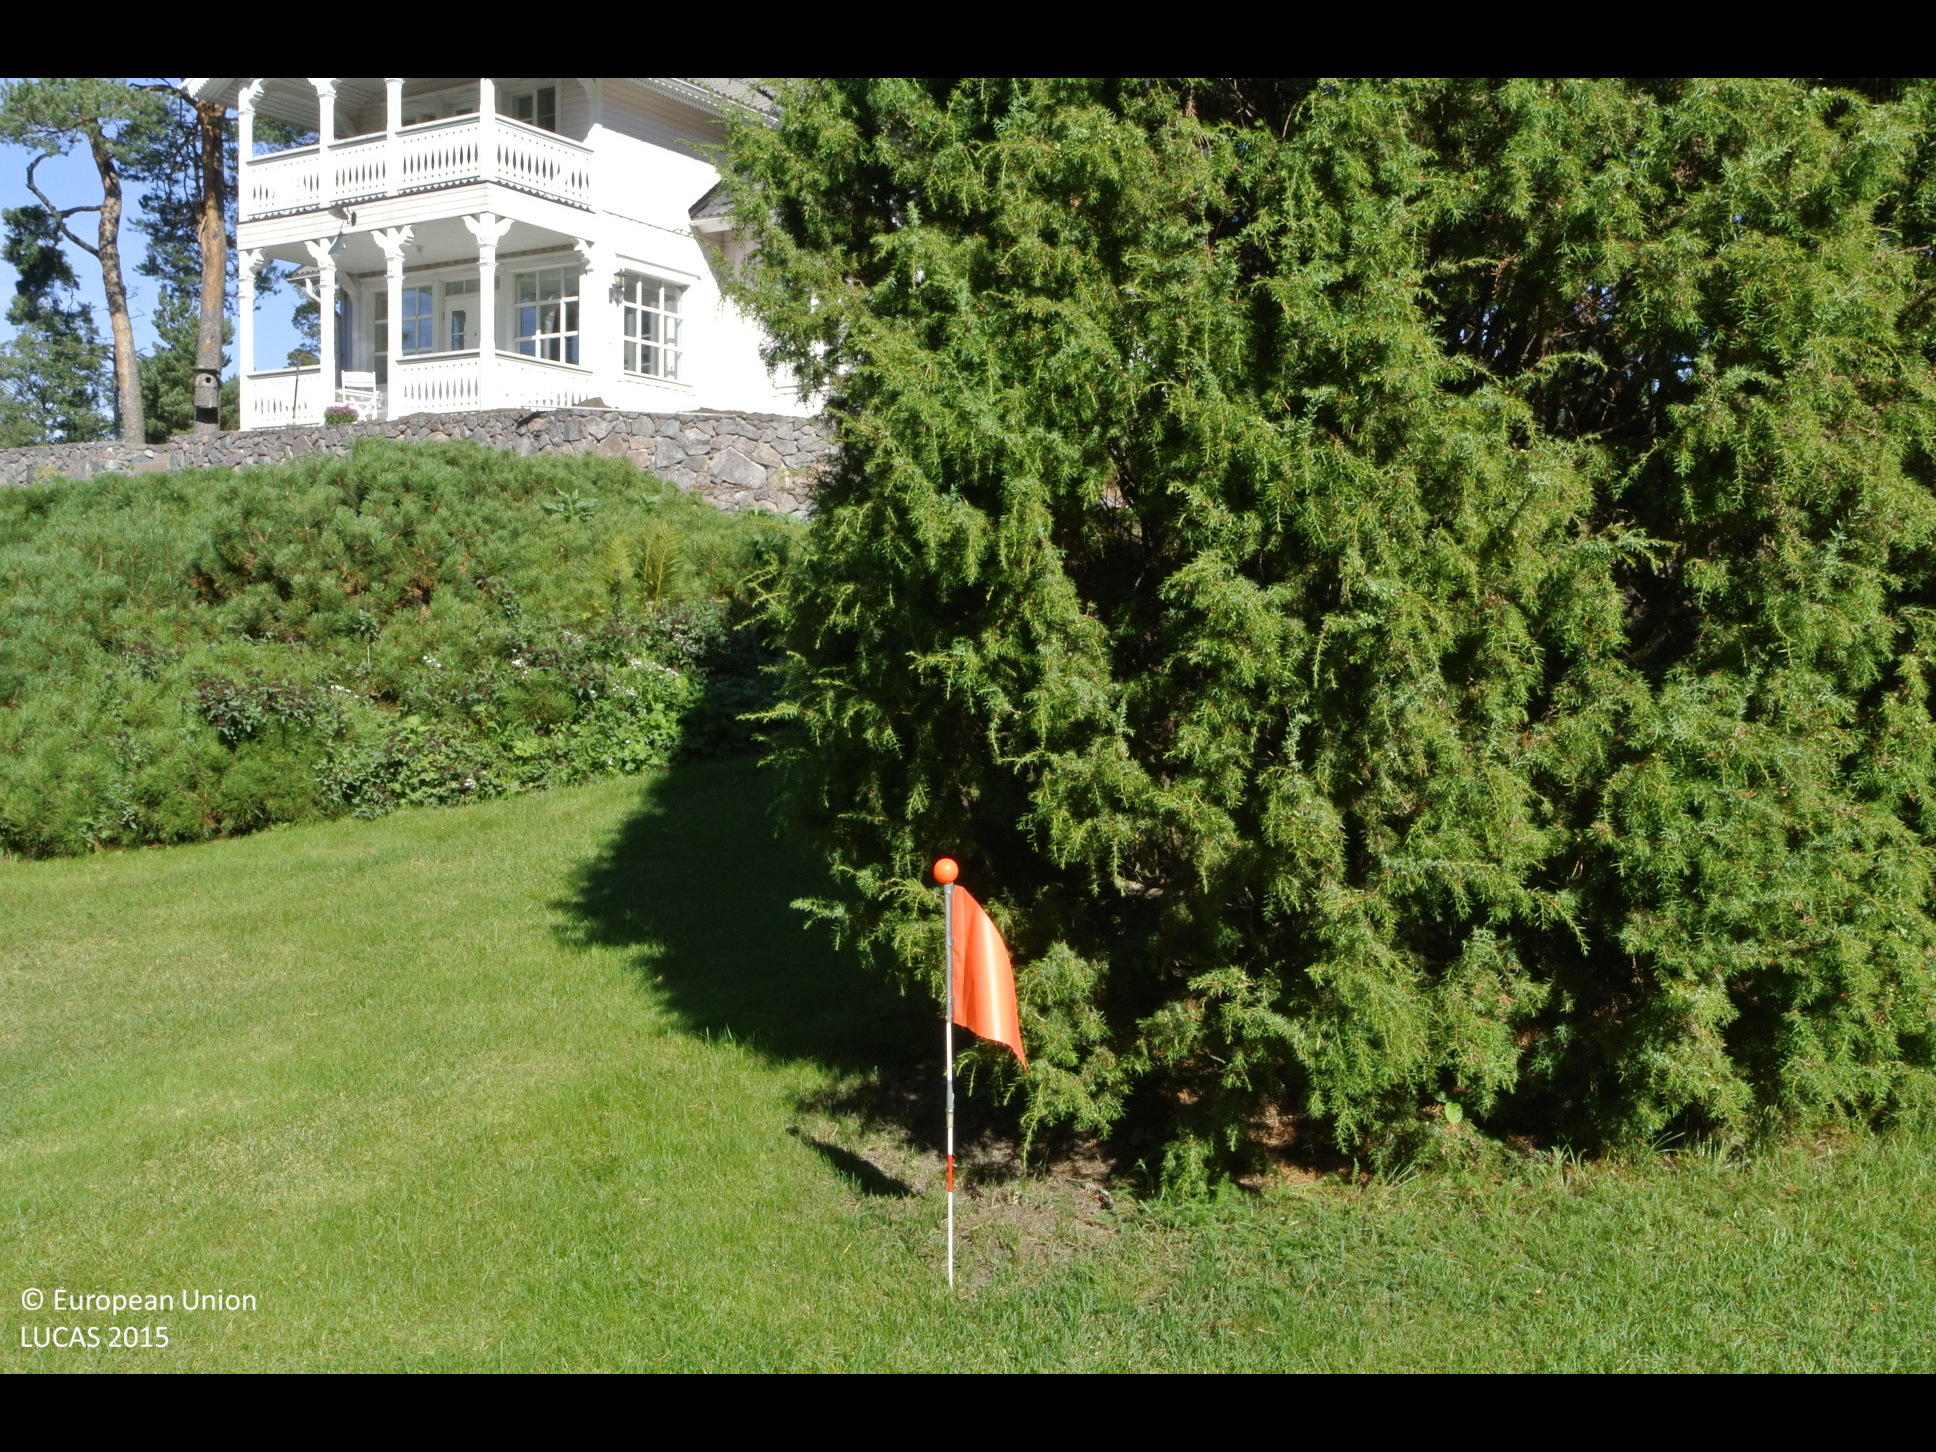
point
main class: Grassland
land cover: Grassland without tree/shrub cover
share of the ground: > 75 %
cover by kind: herbaceous plants 100 %
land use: Residential
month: September
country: FI
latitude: 60.2496
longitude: 25.2096
